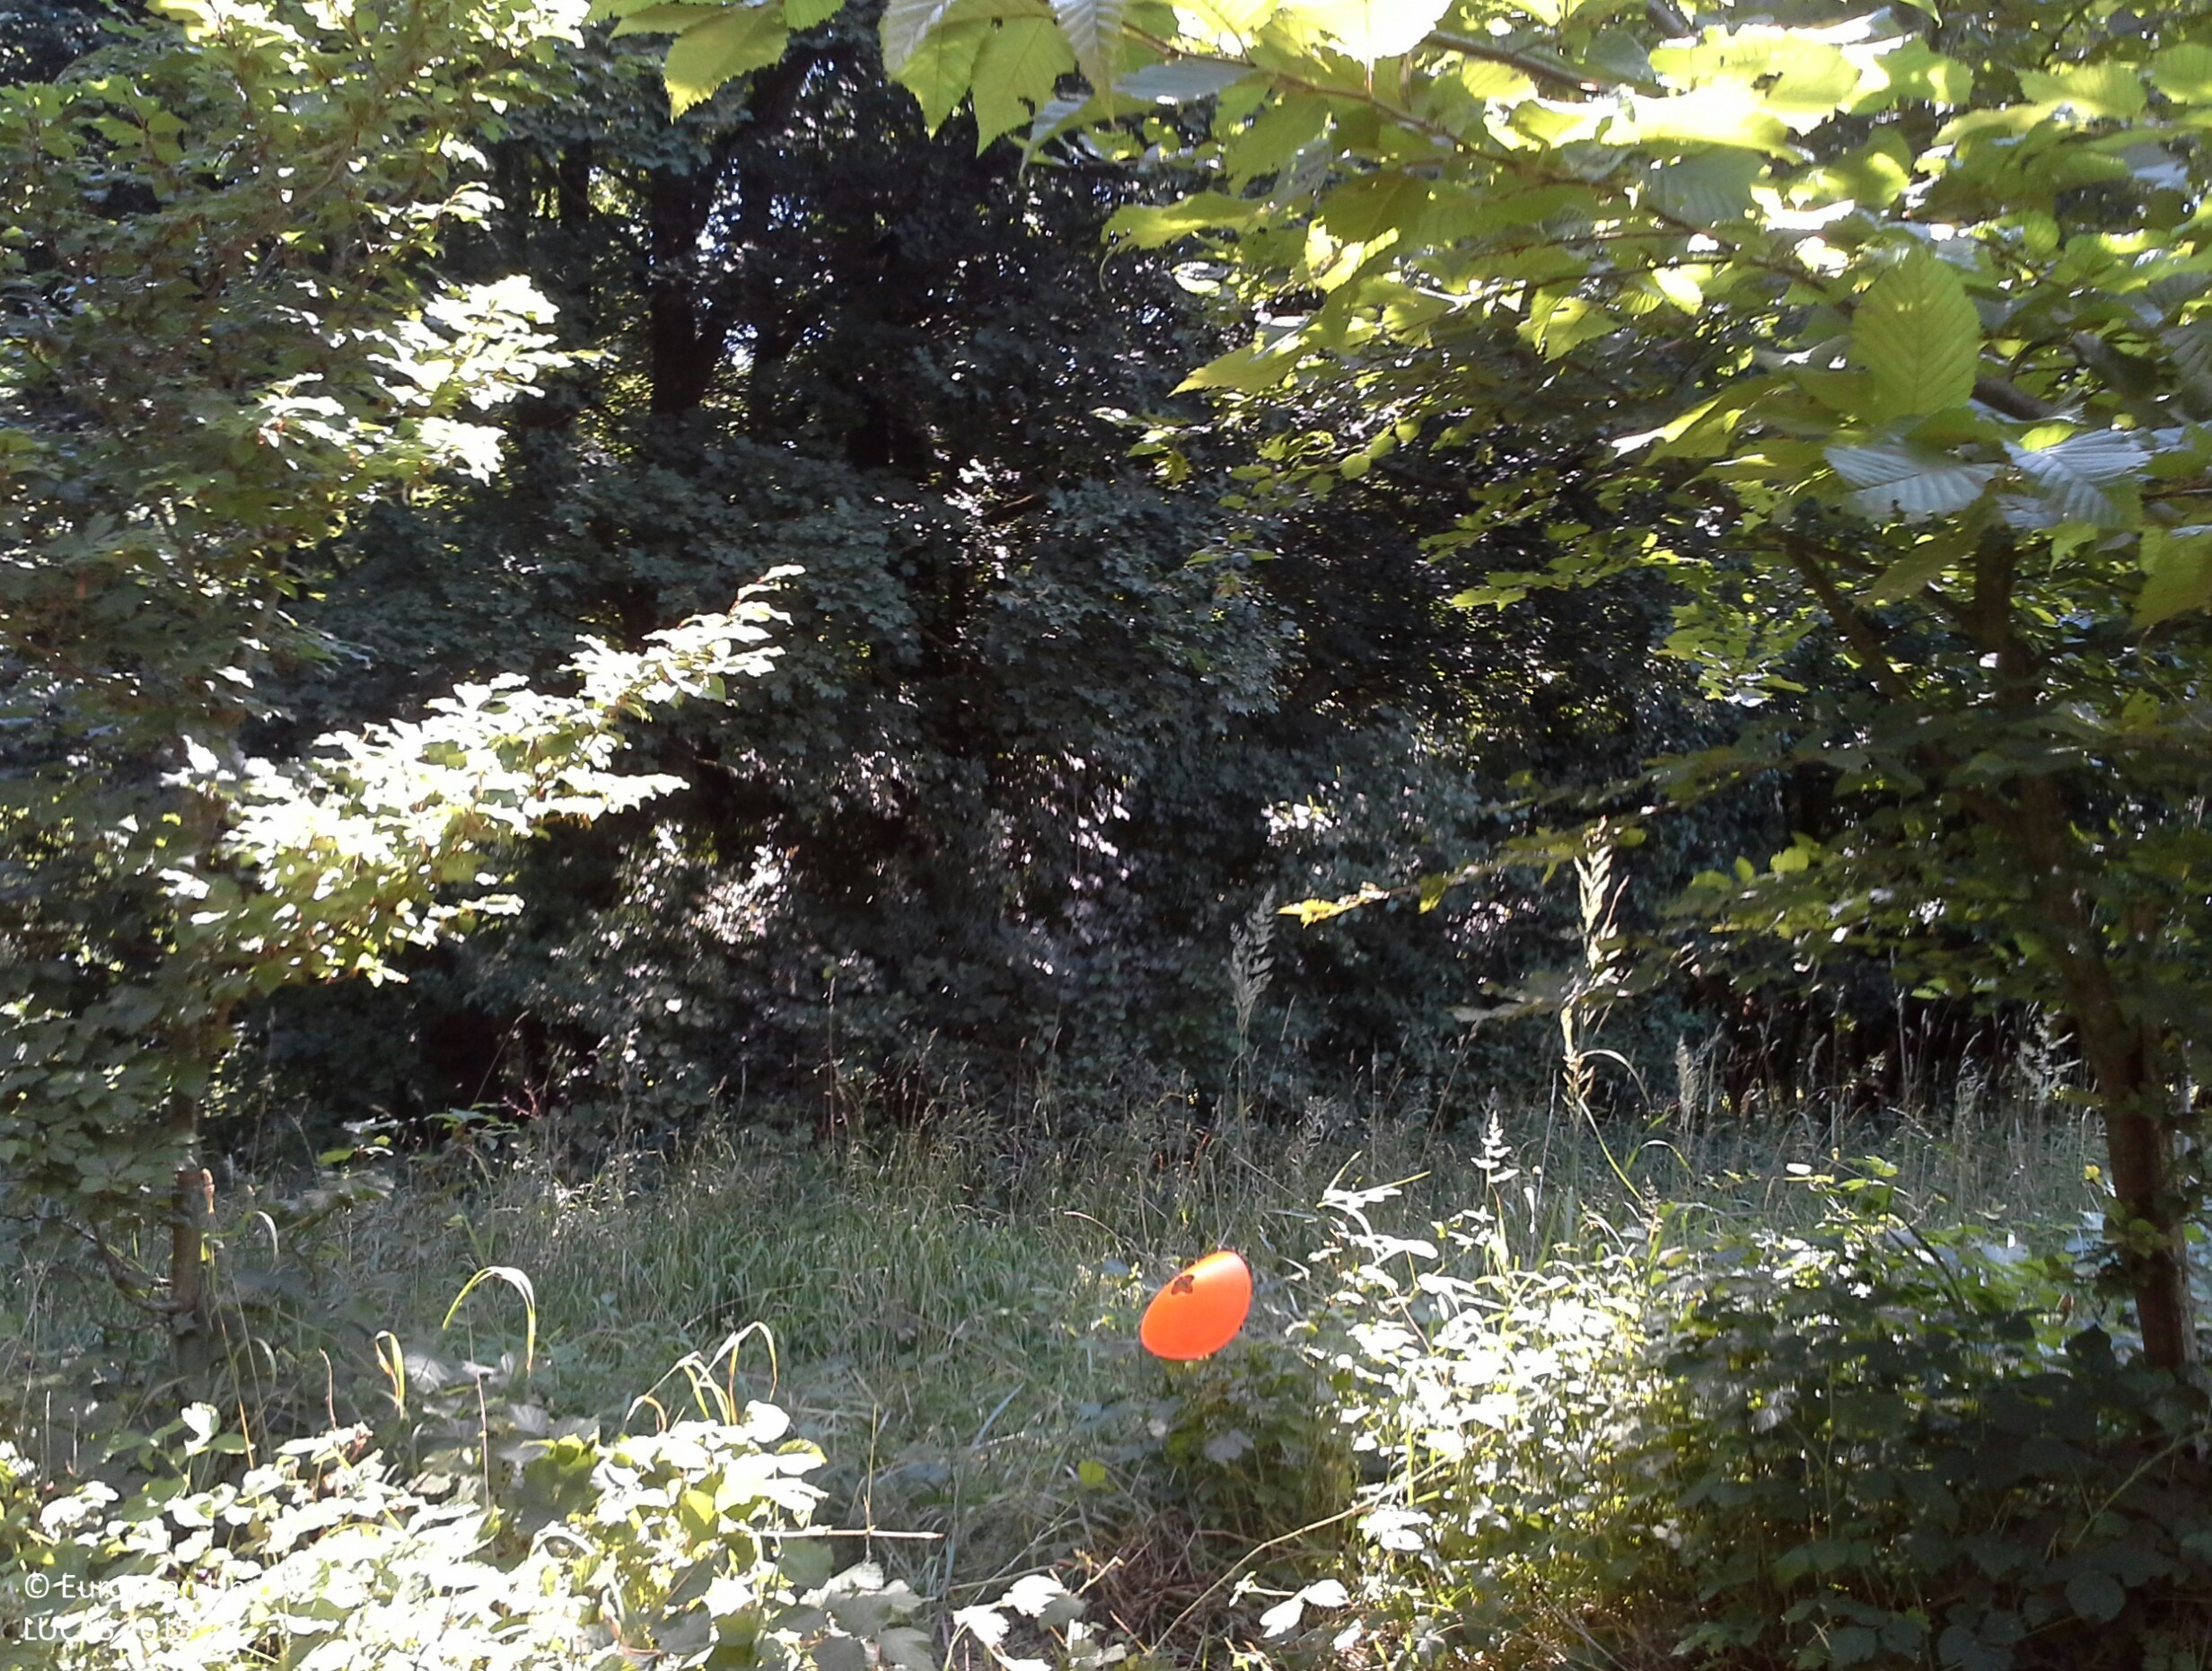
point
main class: Woodland
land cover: Broadleaved woodland
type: mesophytic deciduous forest
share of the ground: > 75 %
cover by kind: broadleaved forest trees 70 %, shrubs 15 %, herbaceous plants 15 %
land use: Forestry
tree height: < 5 m
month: July
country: AT
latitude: 48.0989
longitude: 14.8483
